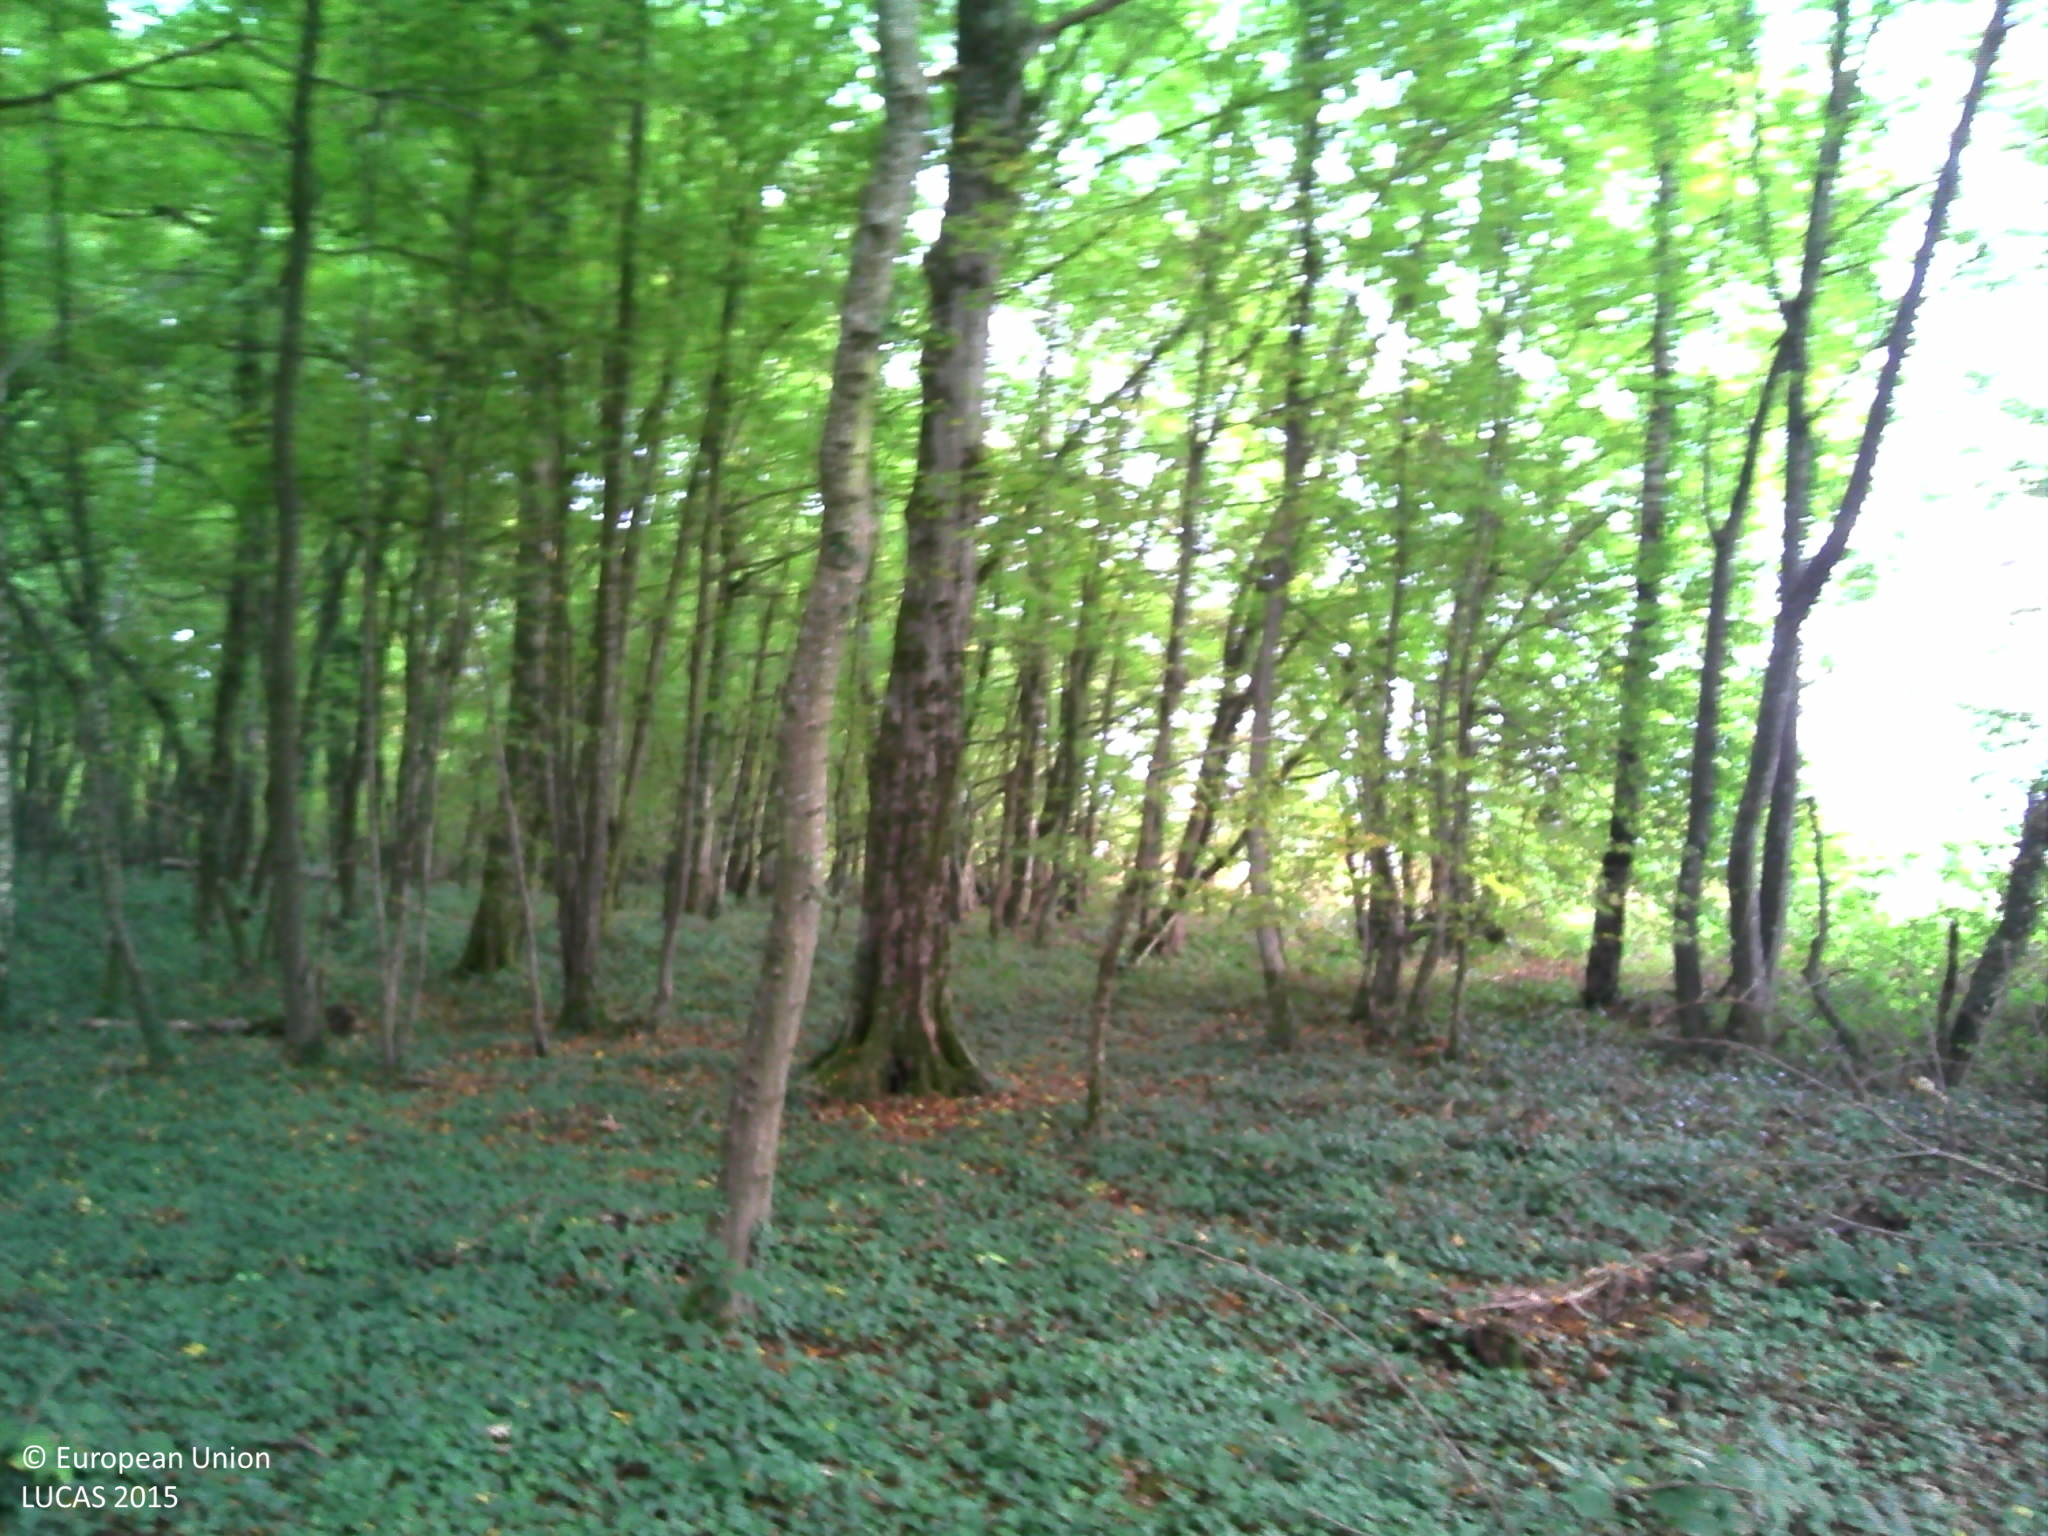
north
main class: Woodland
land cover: Broadleaved woodland
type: mesophytic deciduous forest
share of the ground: > 75 %
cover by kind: broadleaved forest trees 90 %, herbaceous plants 10 %
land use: Forestry
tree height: > 5 m
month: October
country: FR
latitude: 46.0859
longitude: 5.3088
